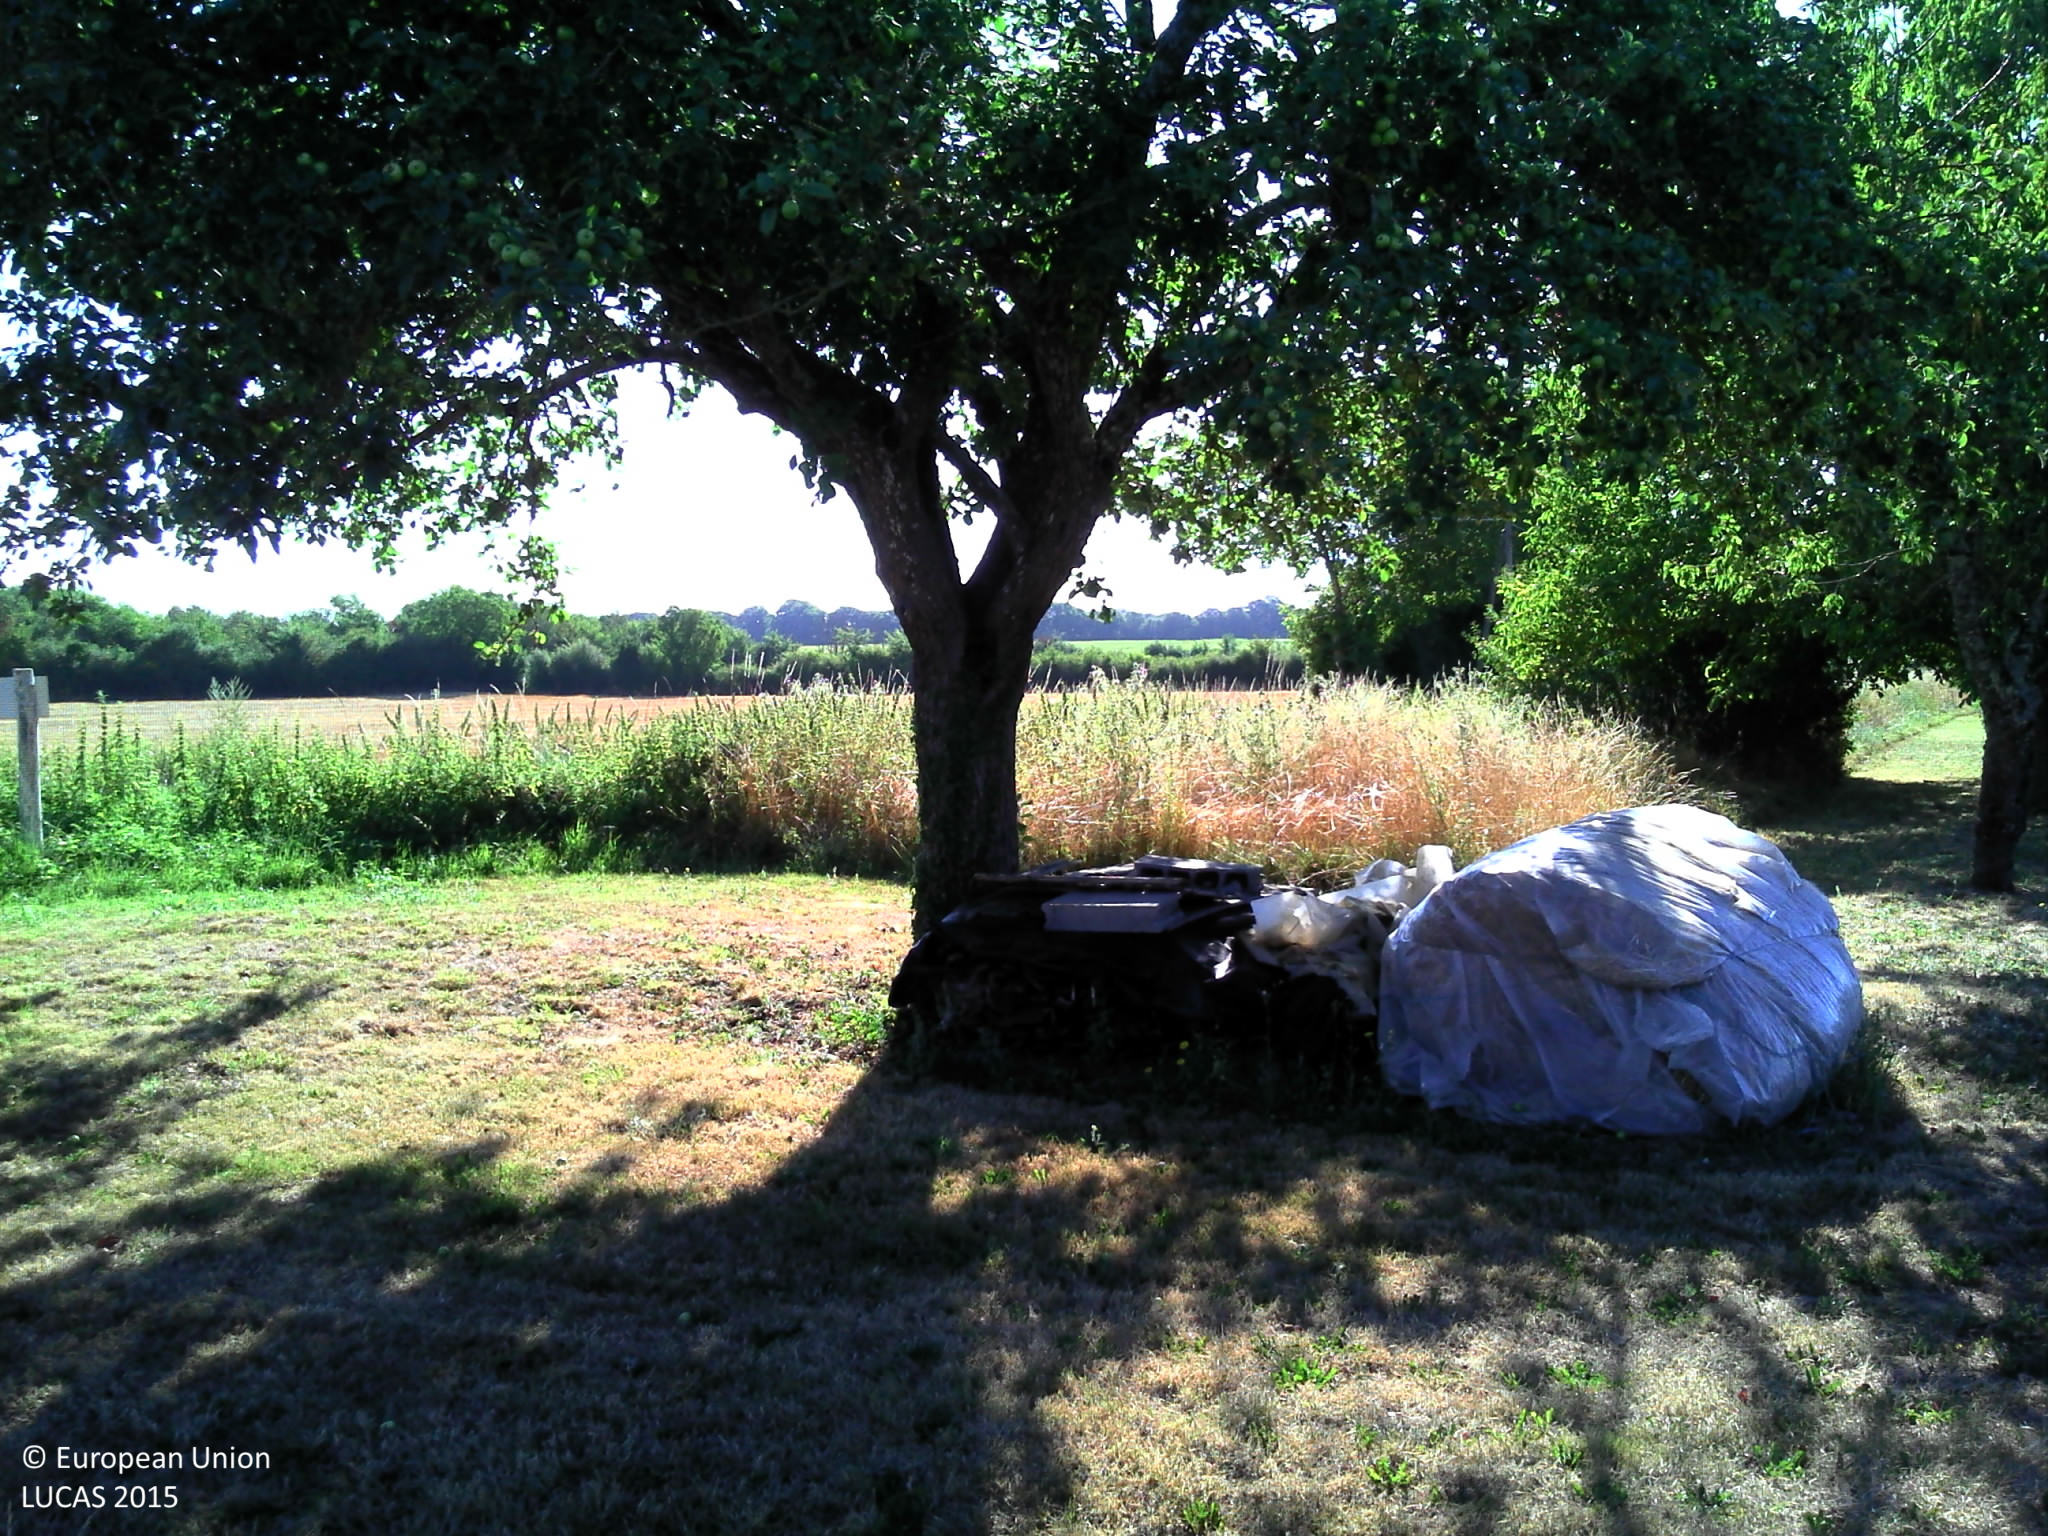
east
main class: Grassland
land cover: Grassland with sparse tree/shrub cover
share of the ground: > 75 %
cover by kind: herbaceous plants 95 %, broadleaved forest trees 5 %
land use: Residential
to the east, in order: Grassland with sparse tree/shrub cover; Electric lines; Grass margins; Ditches and canals; Paved roads, cycling and walking lanes; Grass margins; Ditches and canals; Common wheat; Abandoned hedges; Common wheat
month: July
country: FR
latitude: 46.3789
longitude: 0.4789
